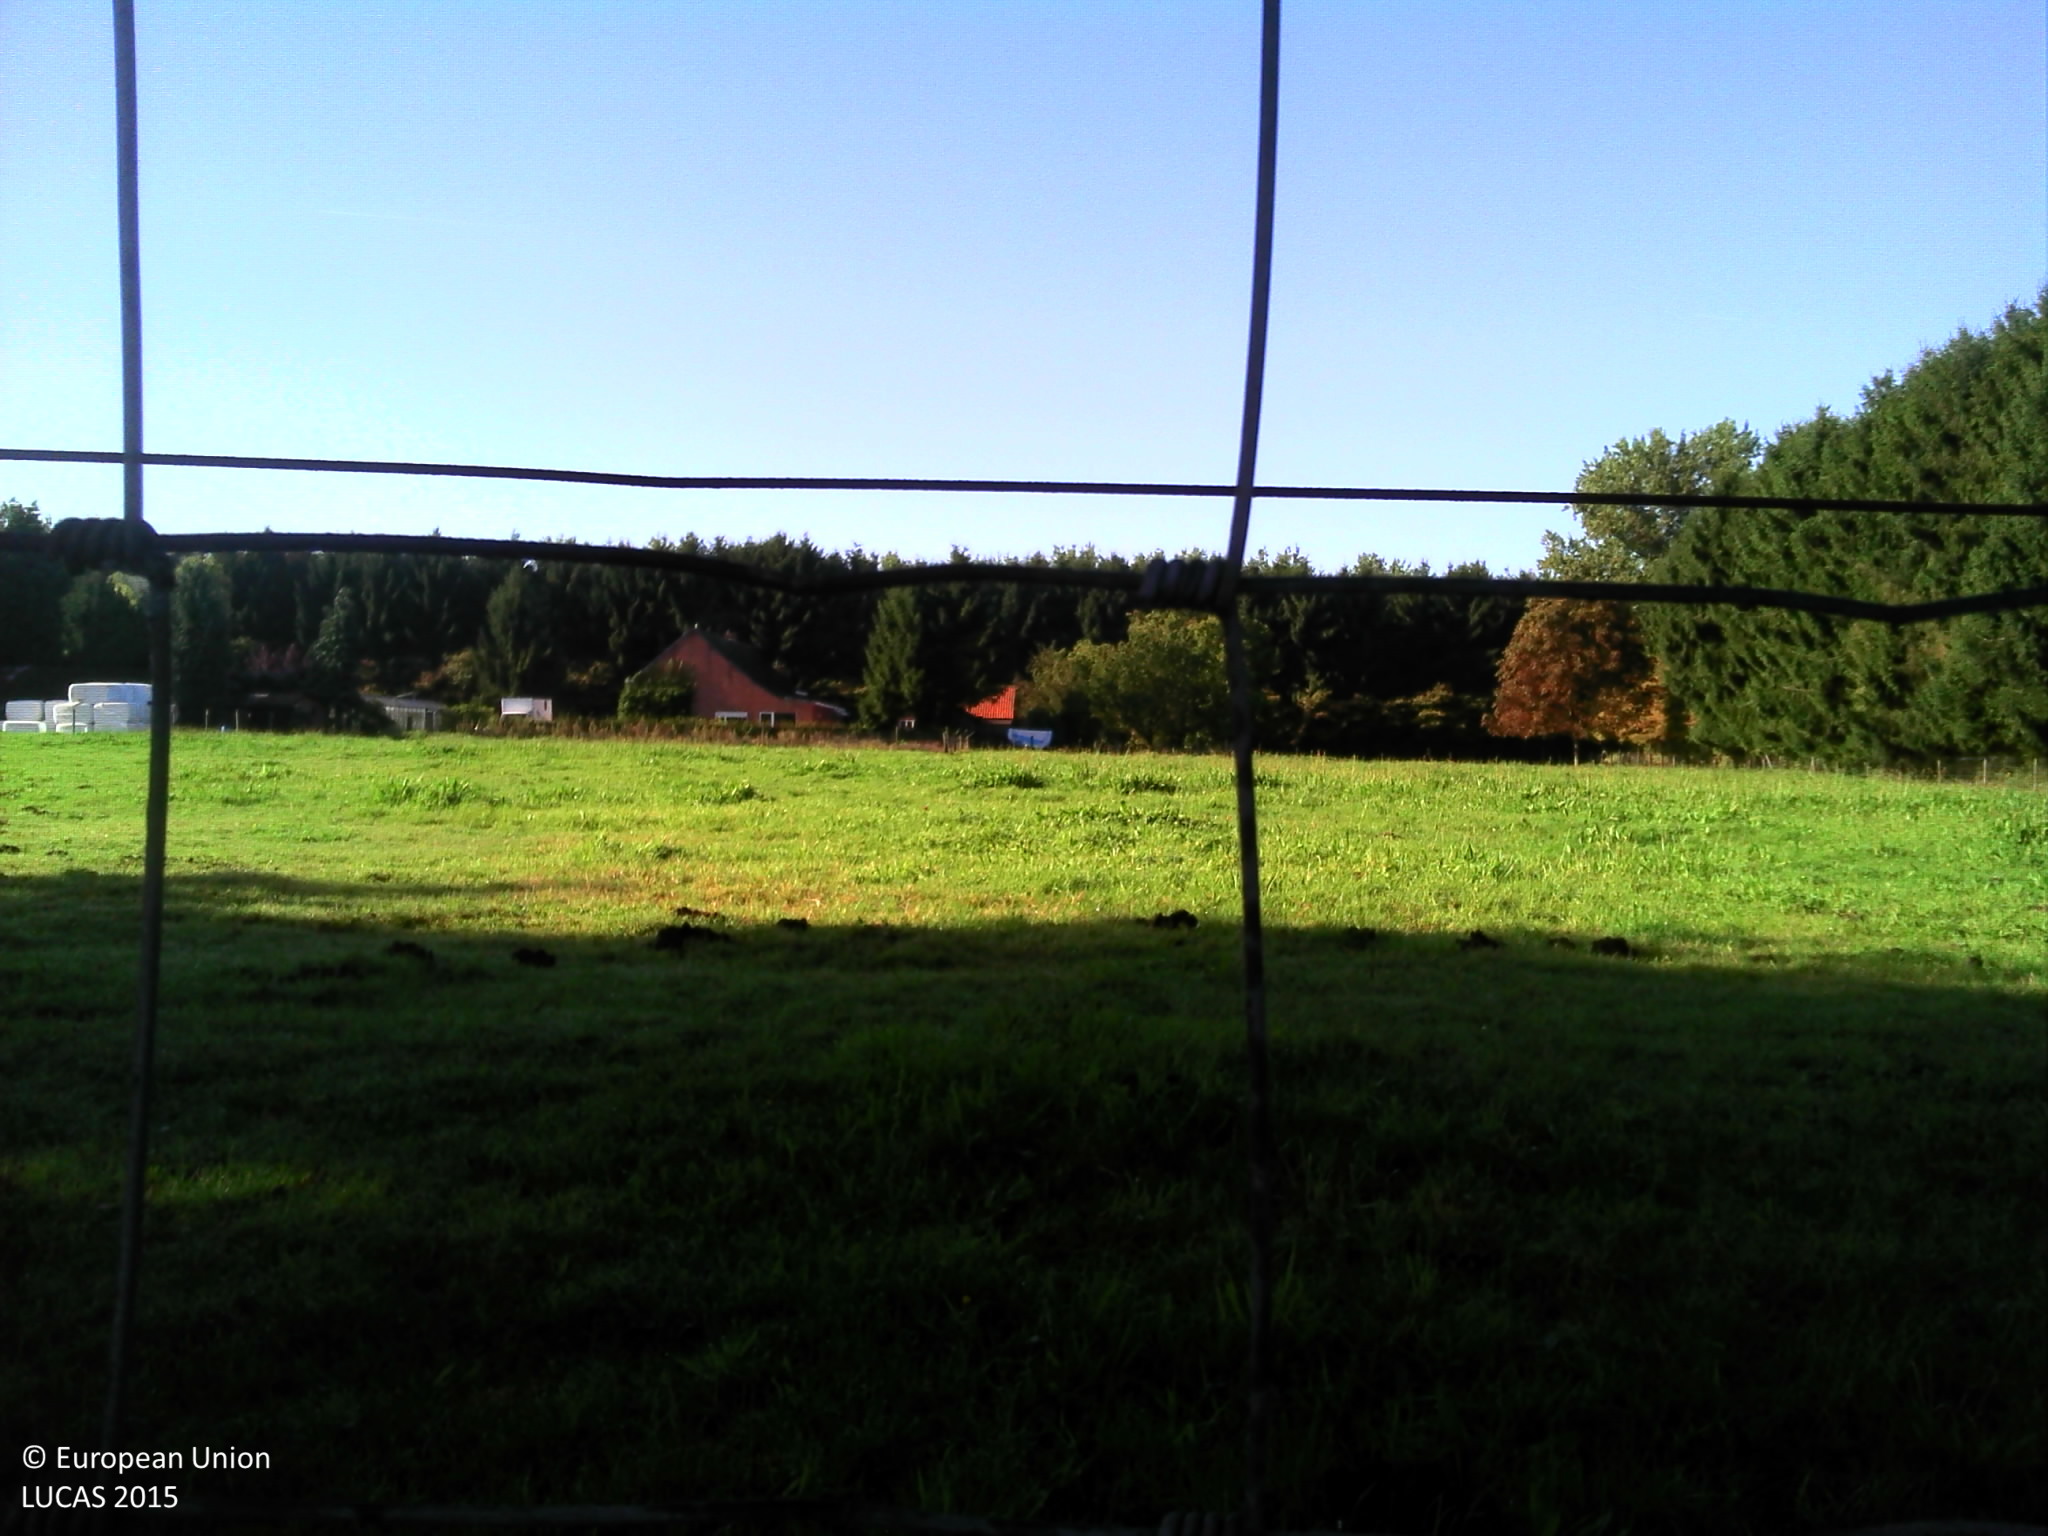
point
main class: Grassland
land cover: Grassland without tree/shrub cover
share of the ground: > 75 %
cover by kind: herbaceous plants 100 %
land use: Agriculture (excluding fallow land and kitchen gardens)
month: September
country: BE
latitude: 51.0815
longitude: 4.5572
